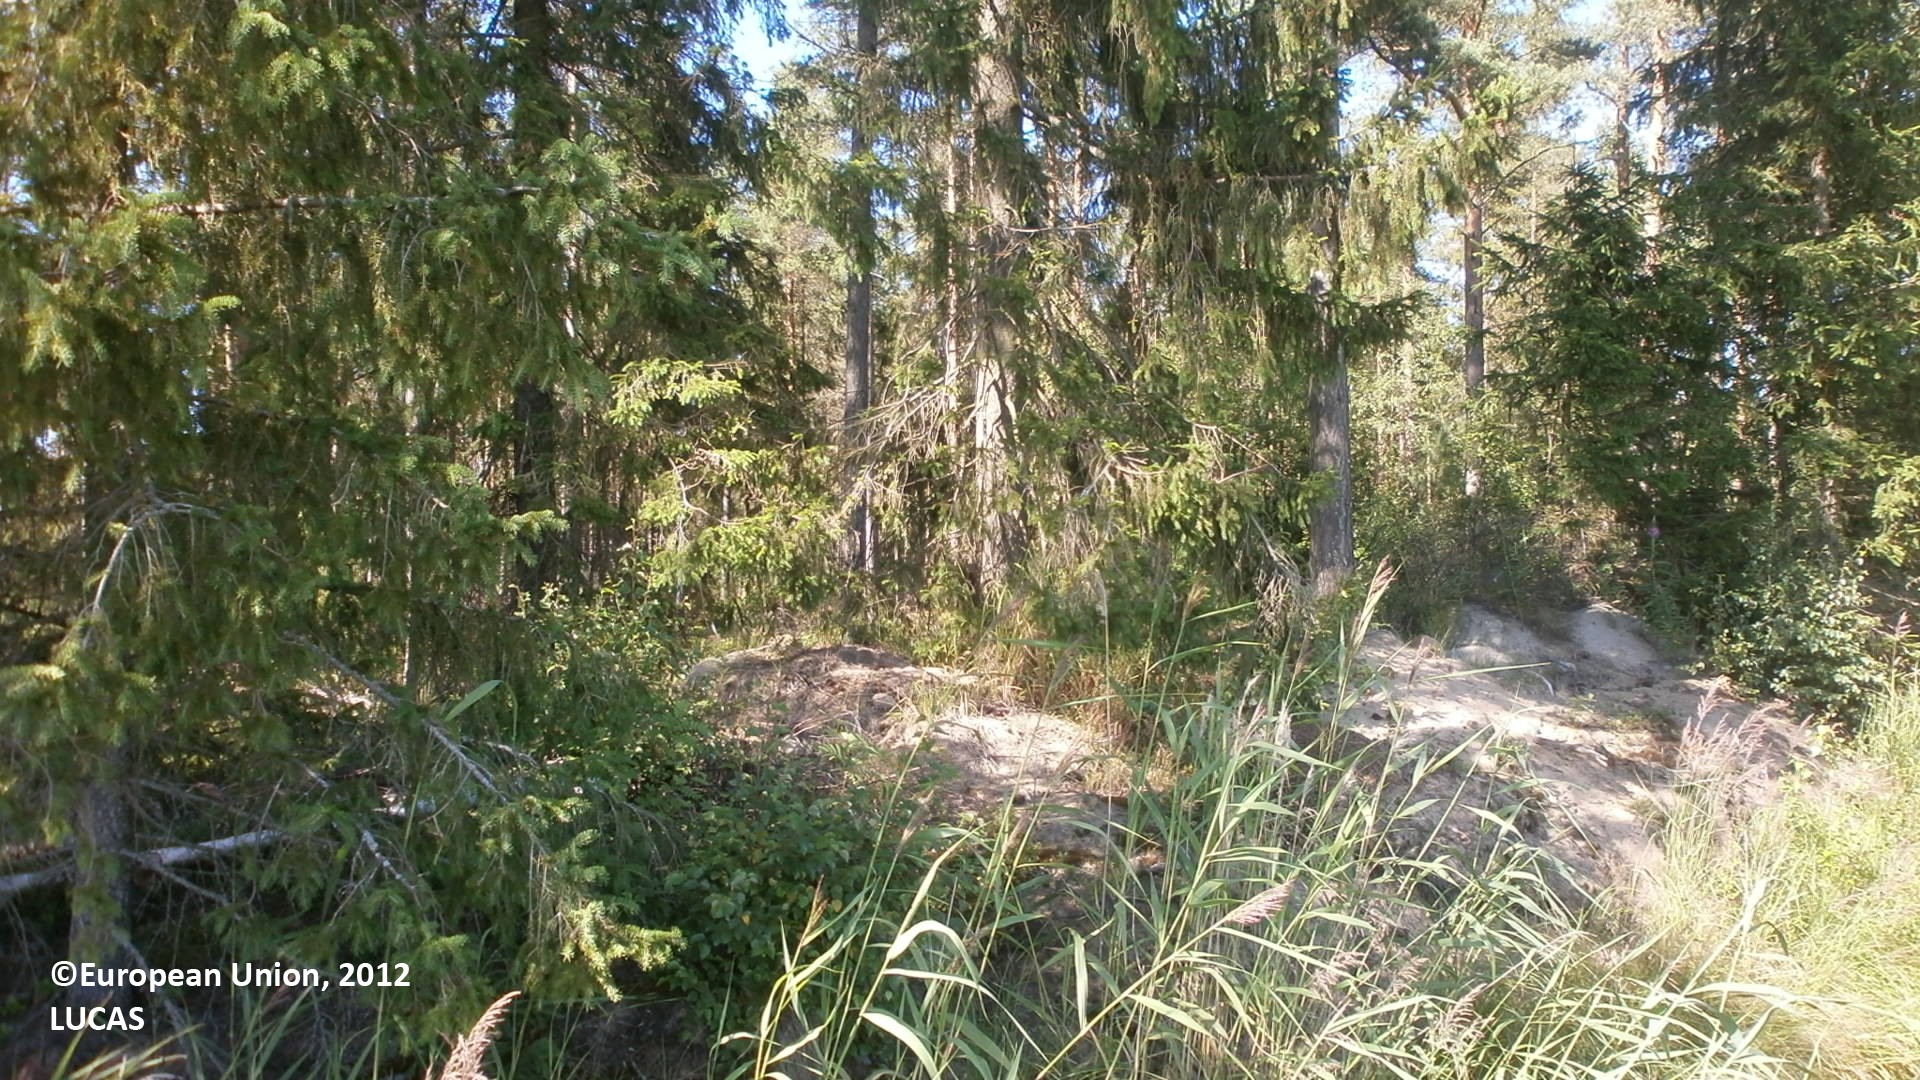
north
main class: Cropland
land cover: Barley
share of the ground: > 75 %
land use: Agriculture (excluding fallow land and kitchen gardens)
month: July
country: FI
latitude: 64.2954
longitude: 23.9267
